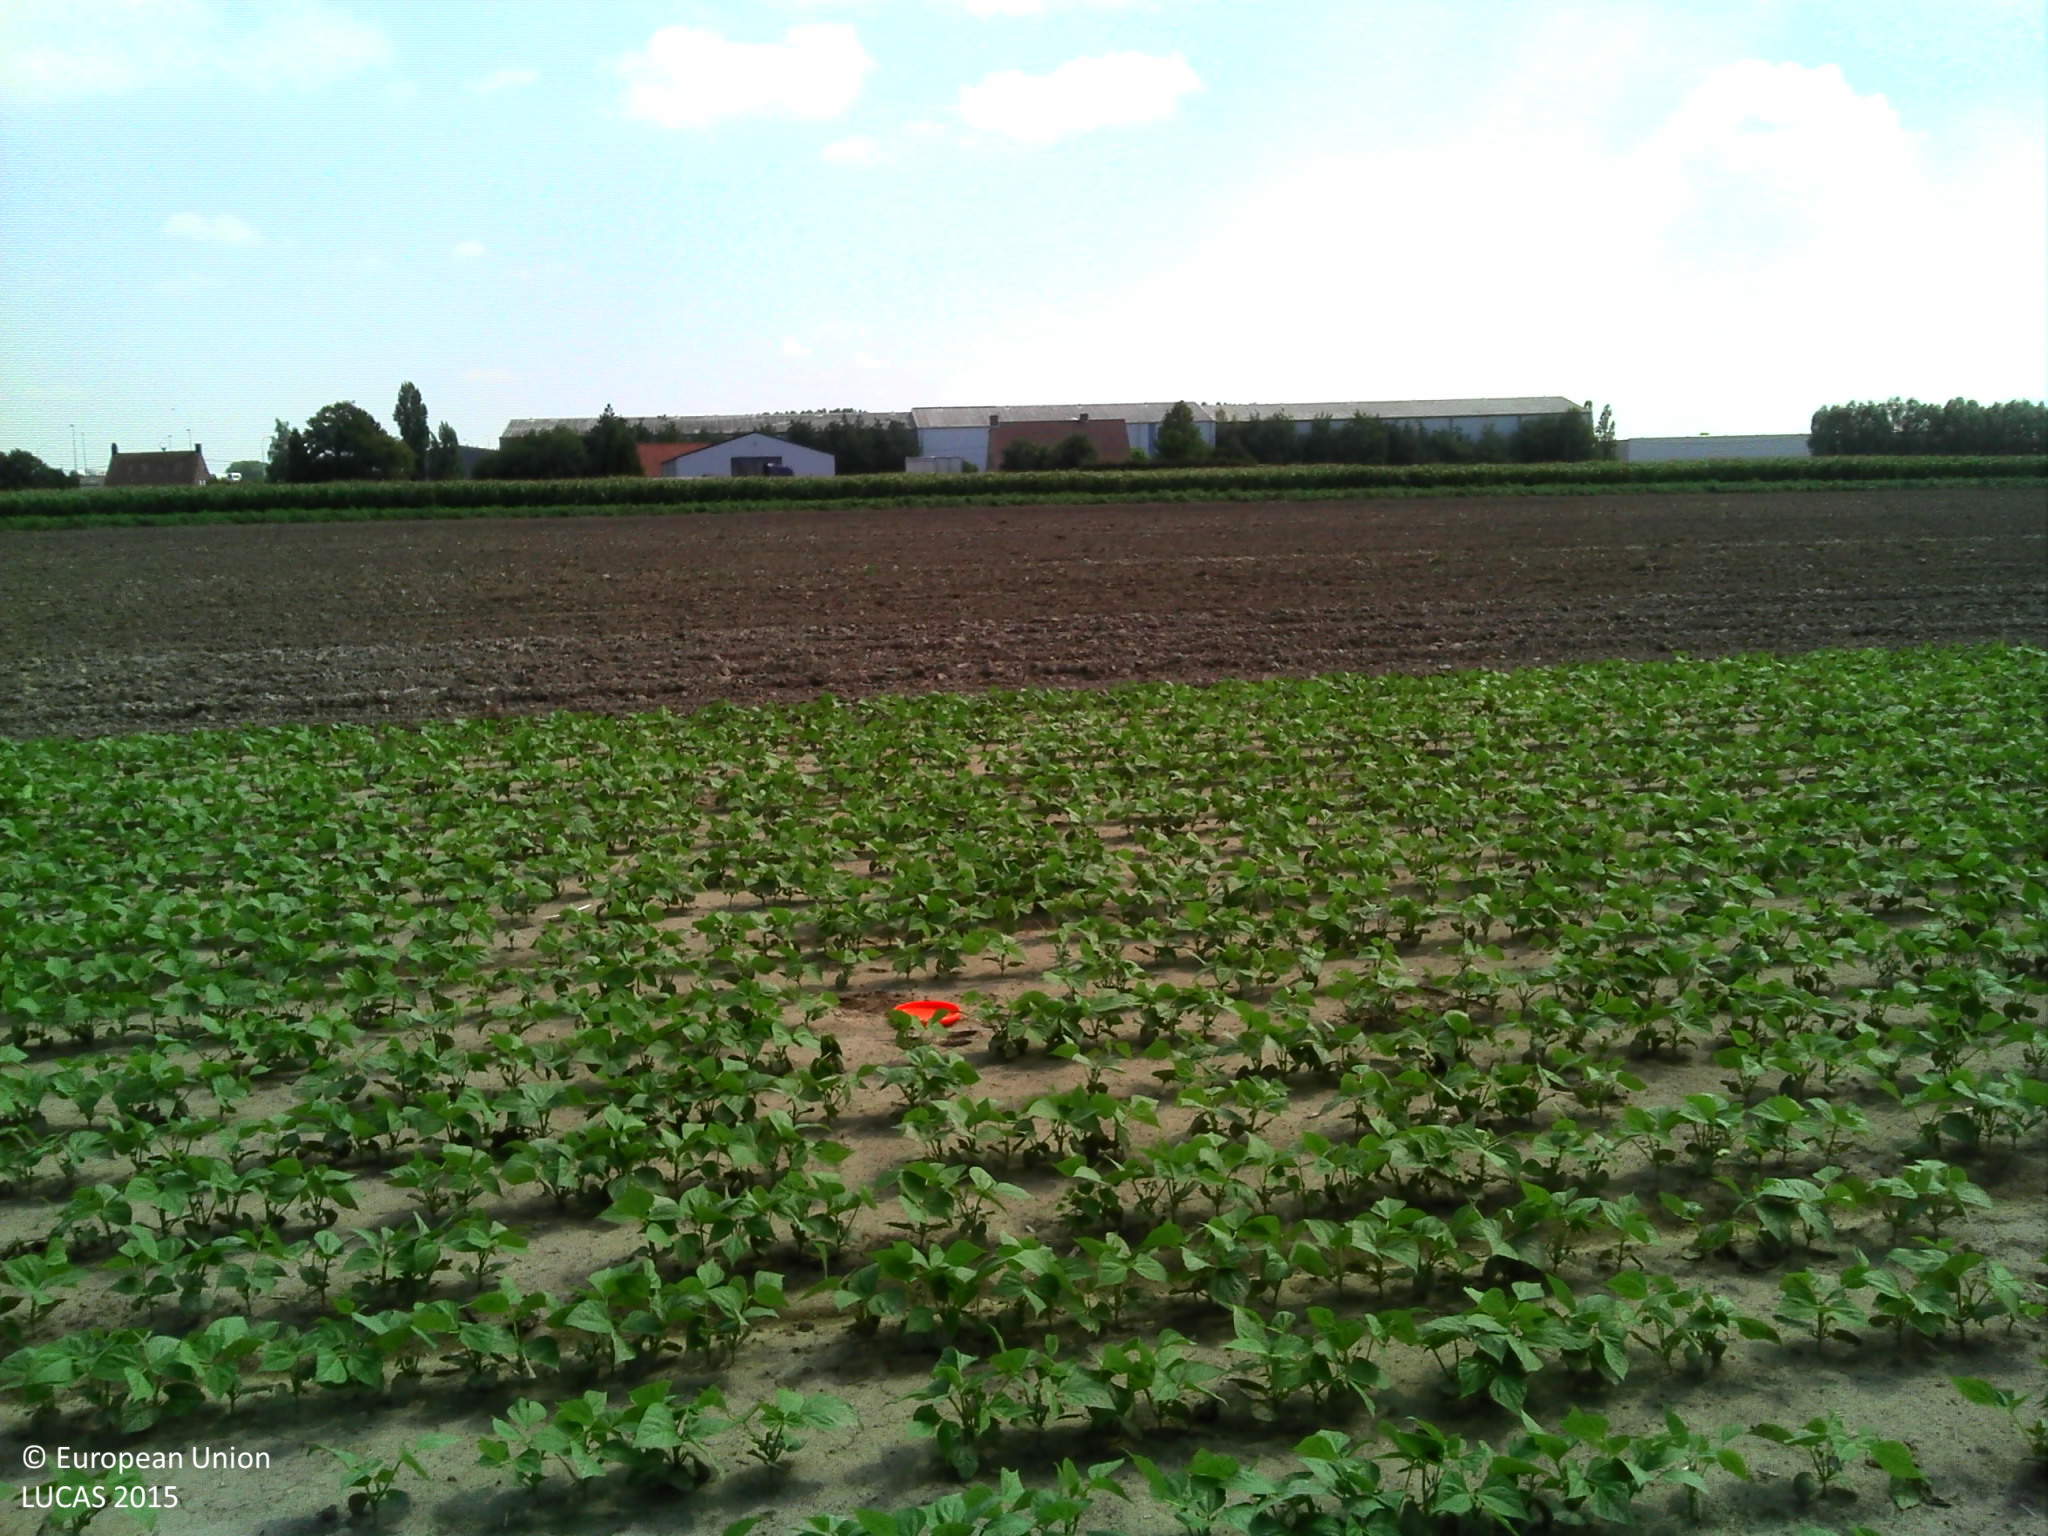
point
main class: Cropland
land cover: Other fresh vegetables
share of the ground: > 75 %
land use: Agriculture (excluding fallow land and kitchen gardens)
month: August
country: BE
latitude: 50.9718
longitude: 3.1692
